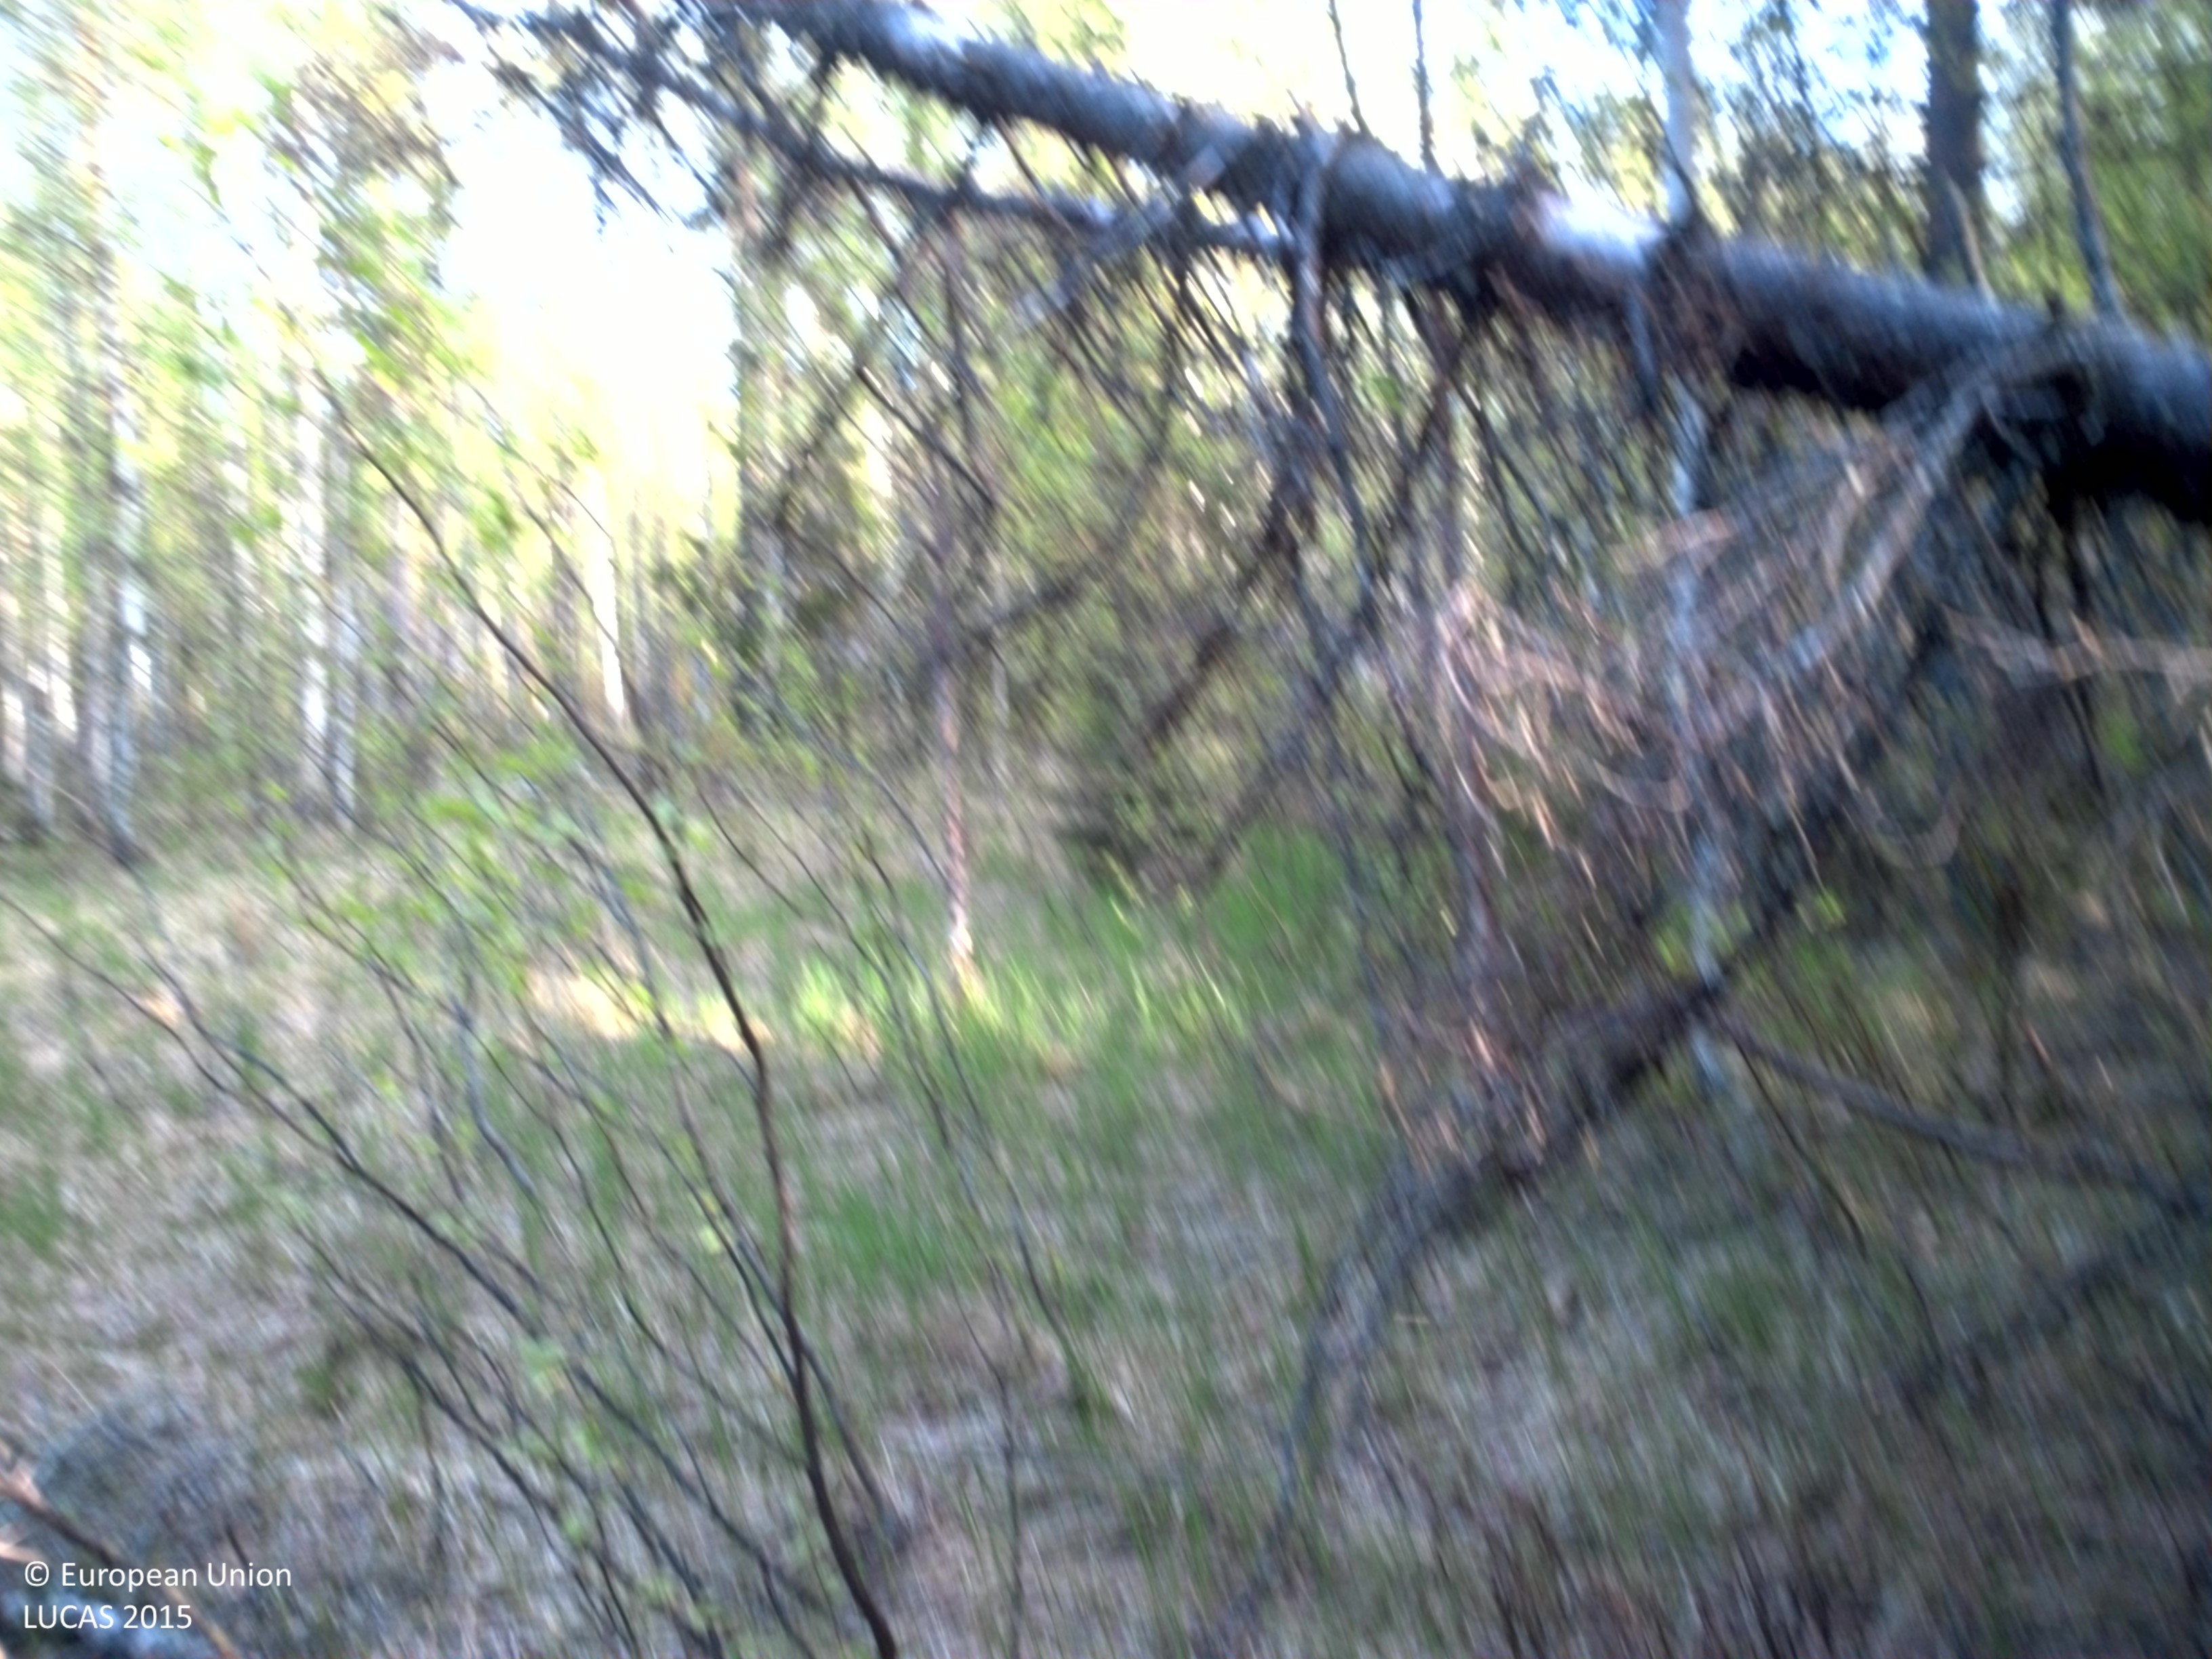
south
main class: Woodland
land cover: Other mixed woodland
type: boreal forest
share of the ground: 25 - 50 %
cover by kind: herbaceous plants 35 %, broadleaved forest trees 30 %, shrubs 20 %, coniferous forest trees 10 %
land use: Forestry
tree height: > 5 m
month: June
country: SE
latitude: 64.2212
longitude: 17.4914
